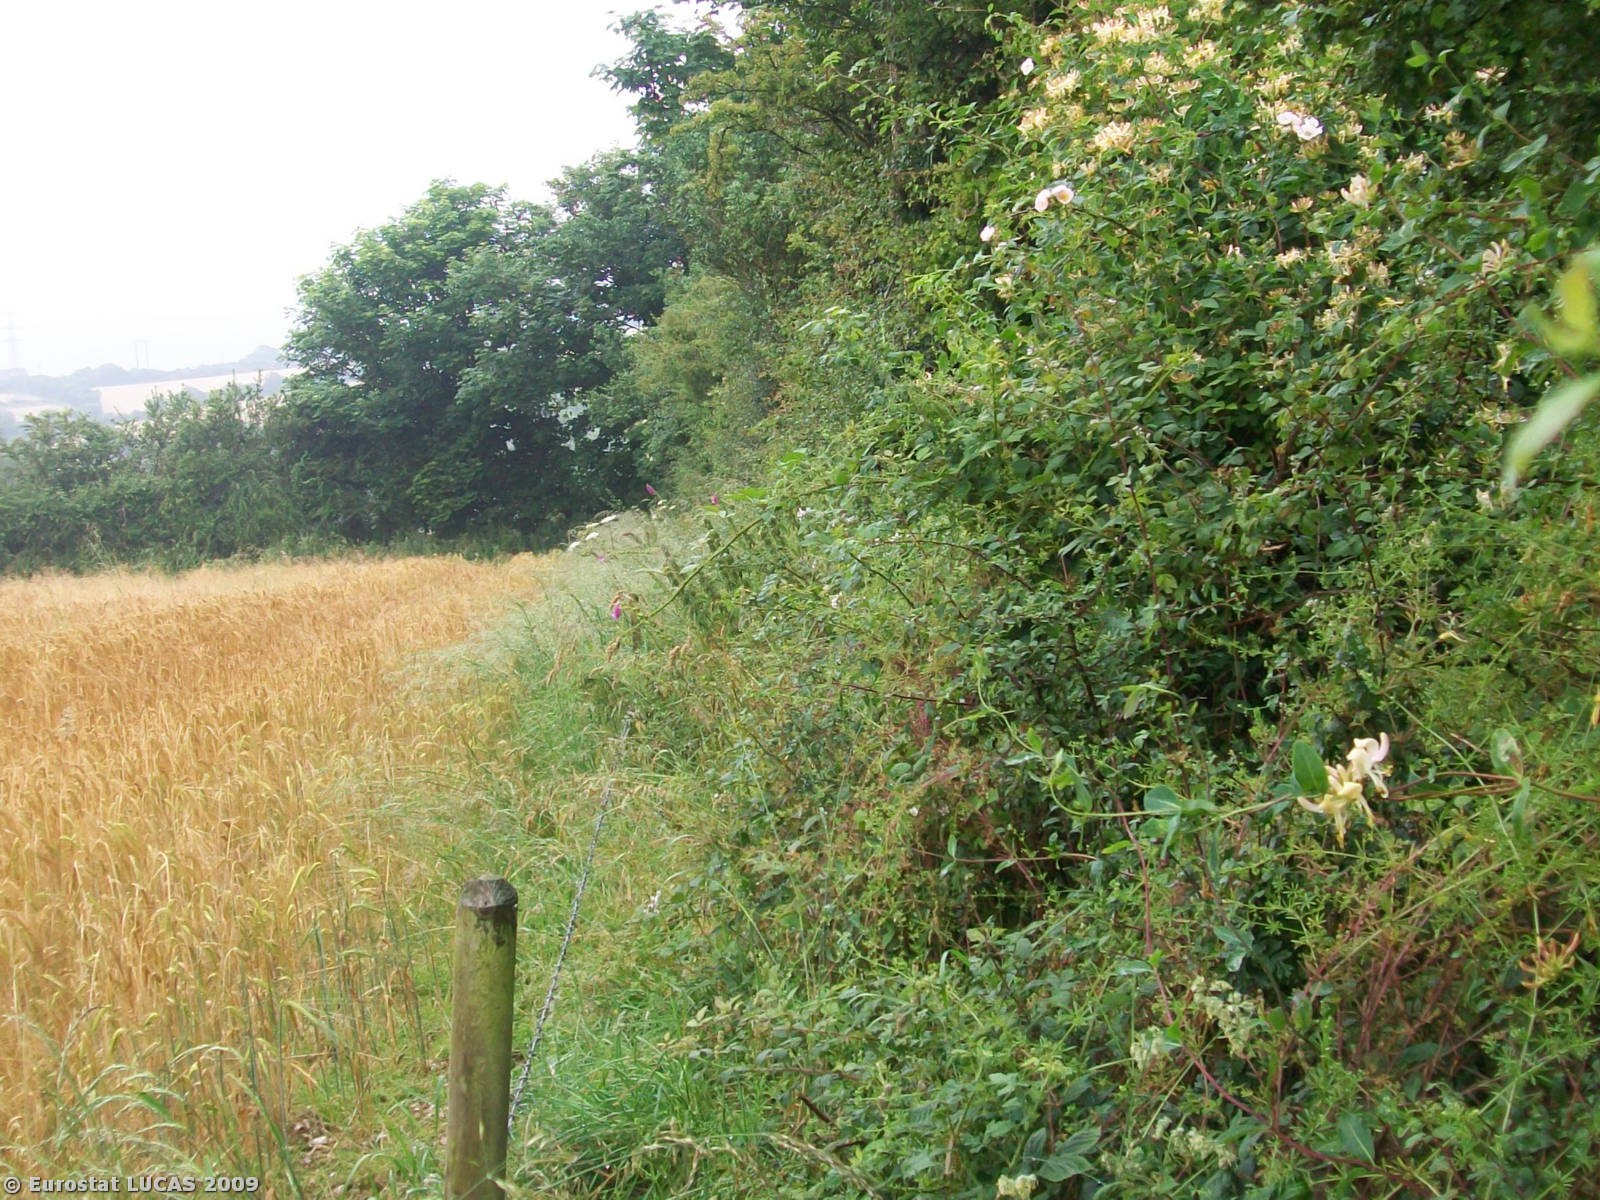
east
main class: Cropland
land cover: Barley
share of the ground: > 75 %
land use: Agriculture (excluding fallow land and kitchen gardens)
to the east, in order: Barley; Fences; Managed hedges; Fences; Grassland without tree/shrub cover; Fences; Abandoned hedges; Fences; Grassland without tree/shrub cover
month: July
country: GB
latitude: 50.2880
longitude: -5.0936
